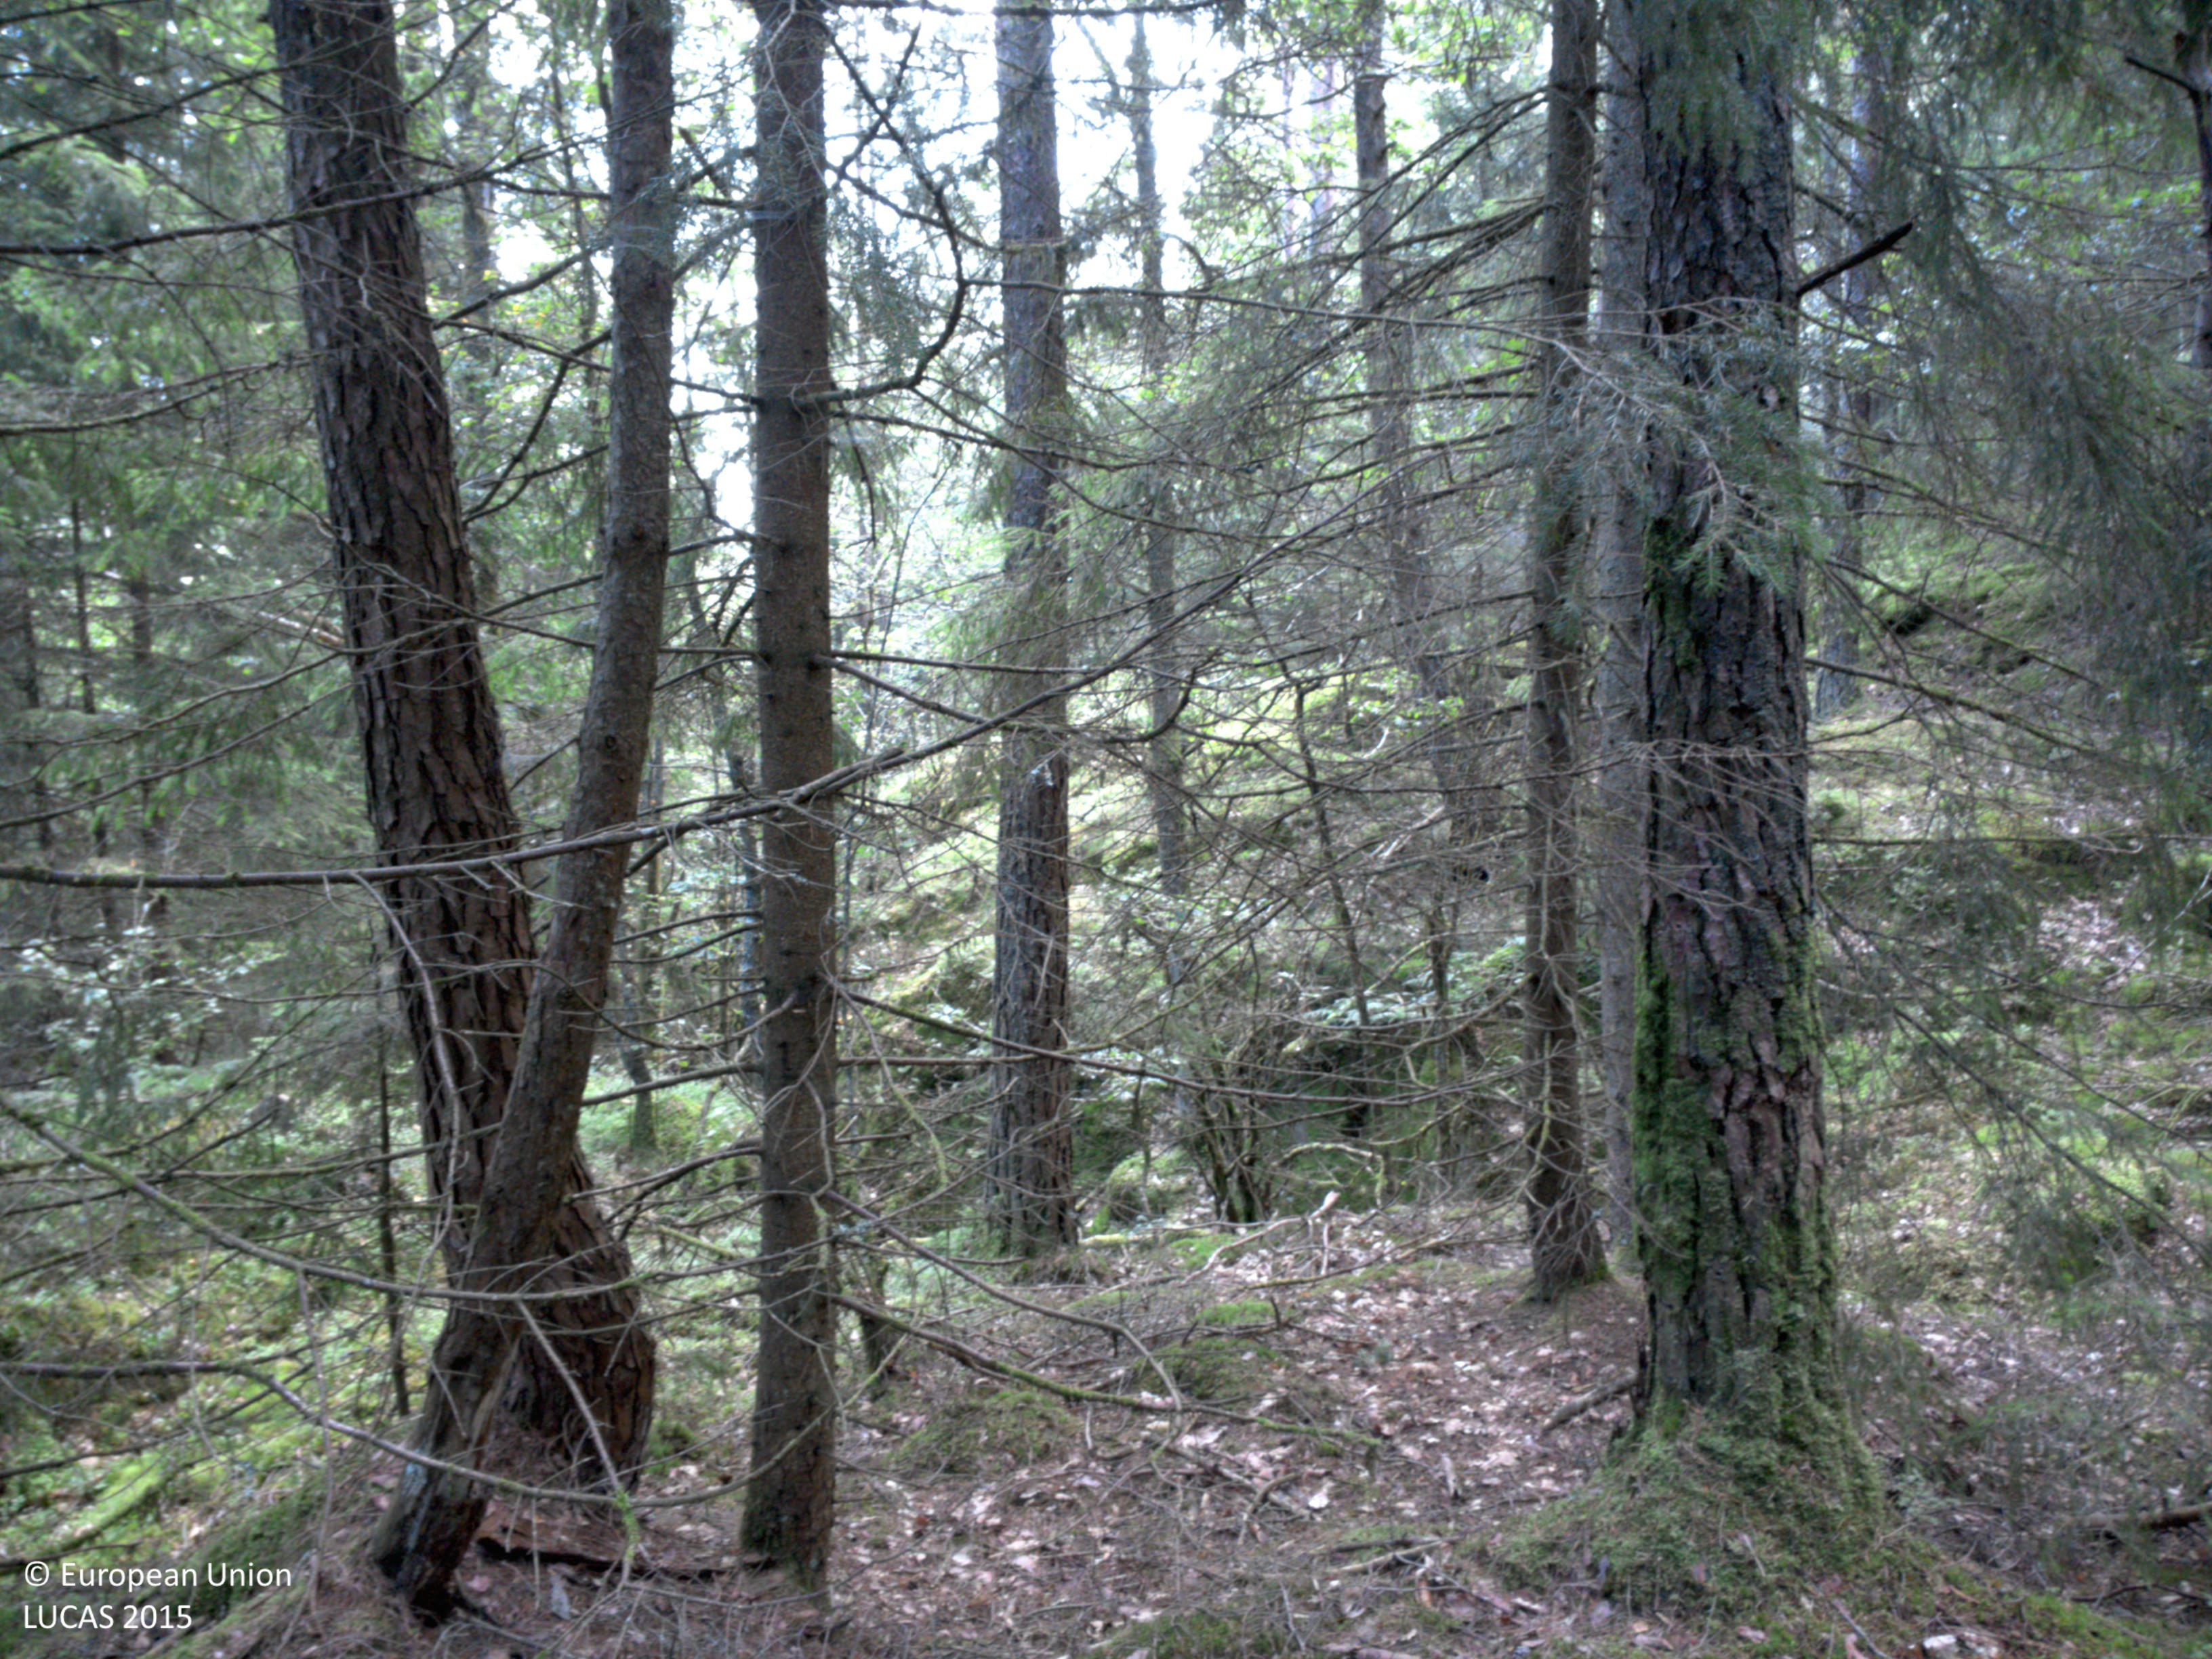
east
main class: Woodland
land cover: Other coniferous woodland
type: boreal forest
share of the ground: 50 - 75 %
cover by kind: coniferous forest trees 50 %, lichens and mosses 35 %, shrubs 15 %
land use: Forestry
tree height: > 5 m
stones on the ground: < 10 %
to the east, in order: Other coniferous woodland; Spruce dominated coniferous woodland; Spruce dominated mixed woodland; Spruce dominated coniferous woodland; Tracks; Pine dominated mixed woodland
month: August
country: SE
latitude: 57.9352
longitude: 11.9725
